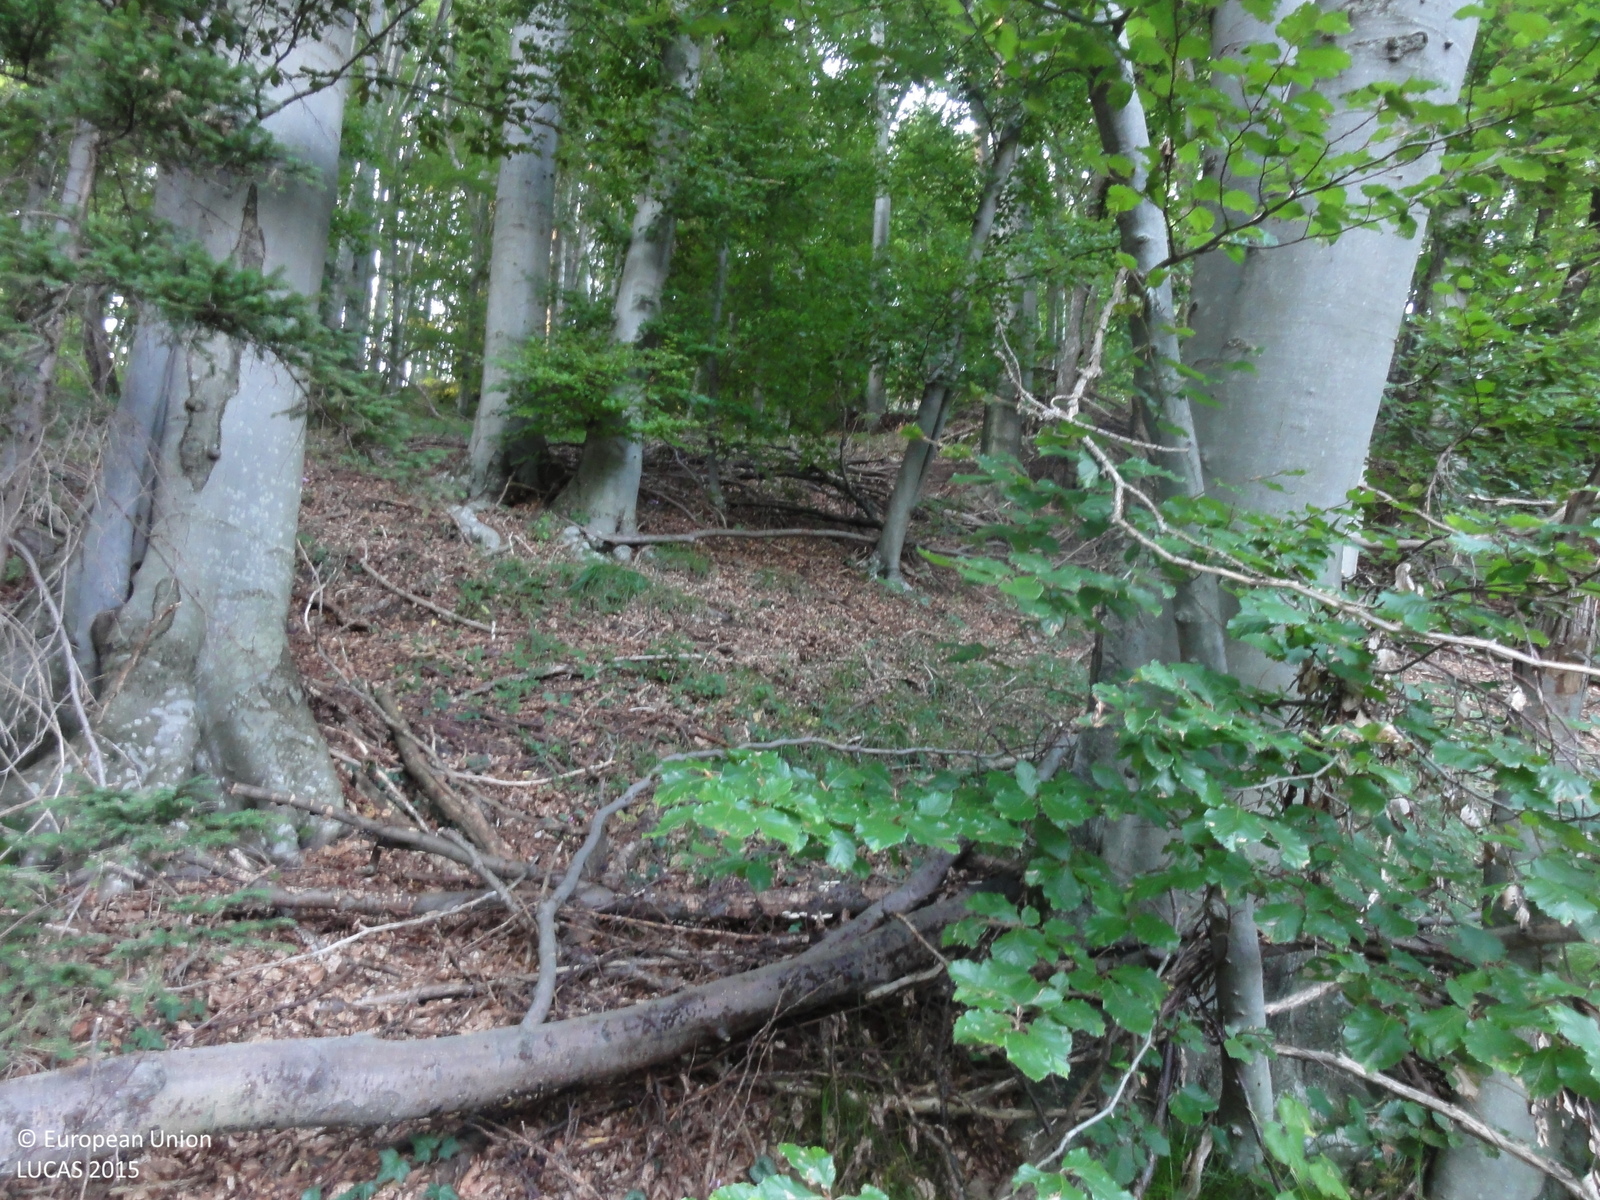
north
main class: Woodland
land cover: Broadleaved woodland
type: beech forest
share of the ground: > 75 %
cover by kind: broadleaved forest trees 90 %, coniferous forest trees 10 %
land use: Forestry
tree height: > 5 m
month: August
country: SI
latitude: 46.0682
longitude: 15.0779
